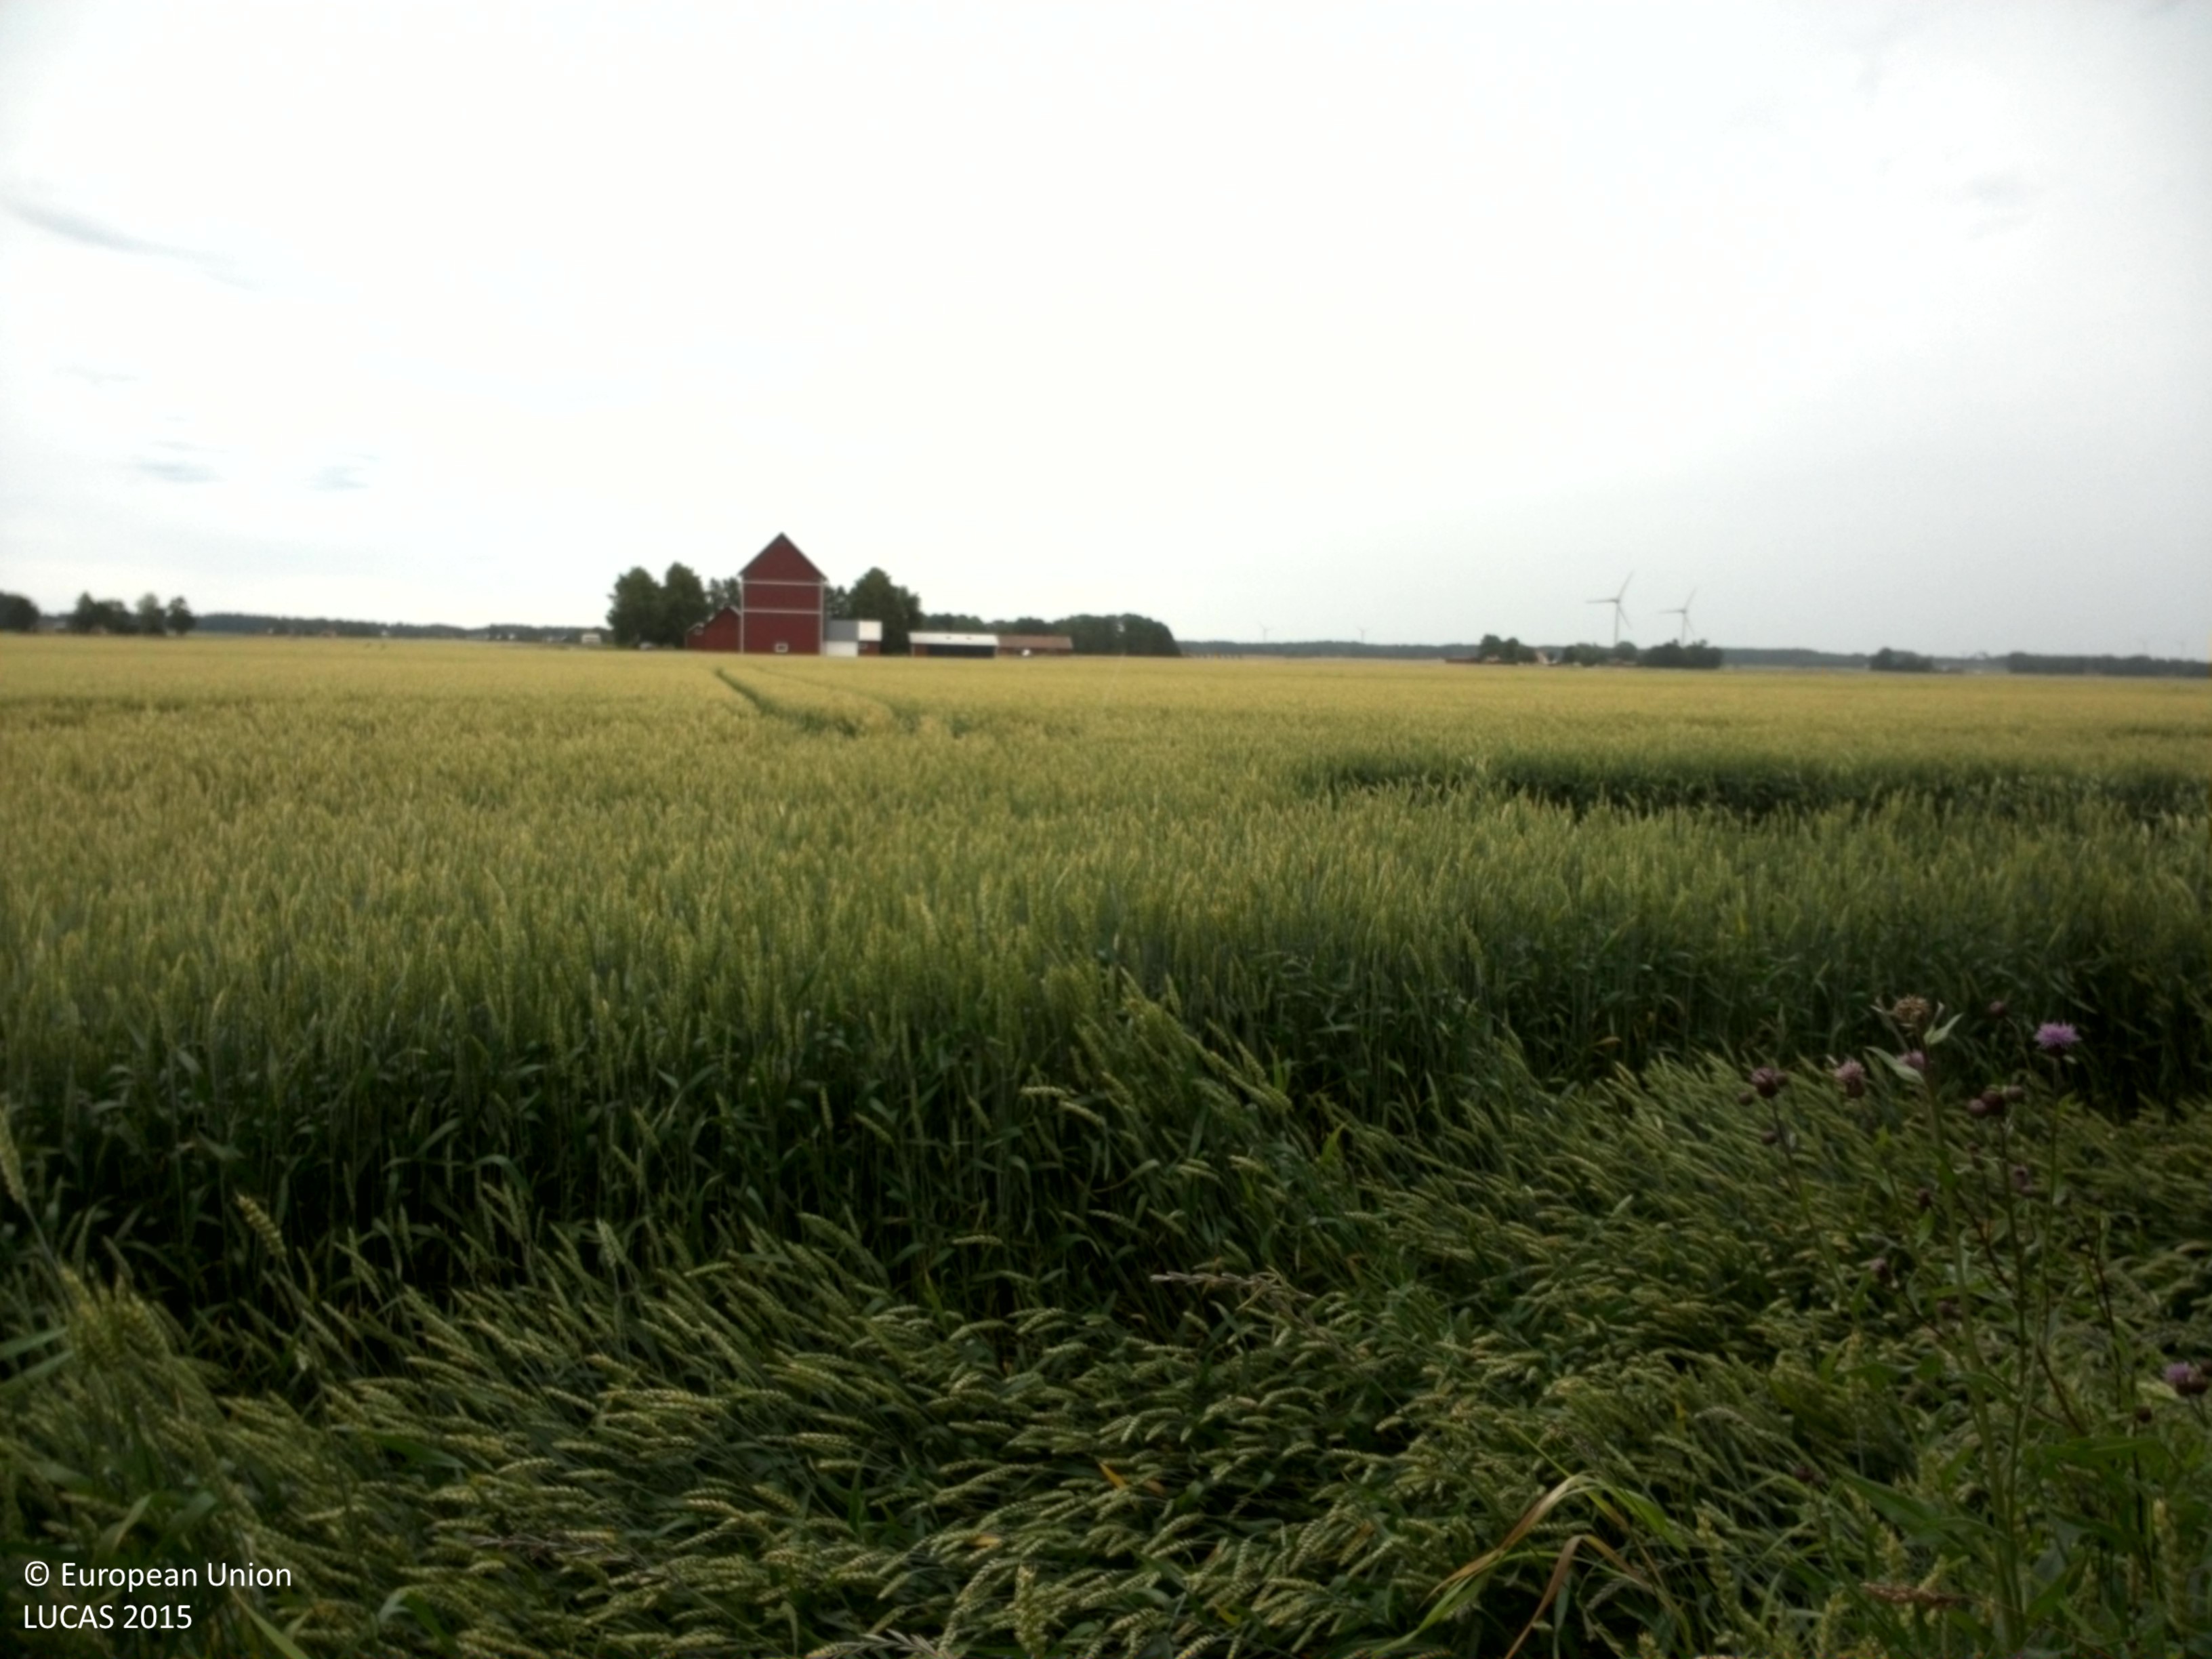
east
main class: Cropland
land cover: Common wheat
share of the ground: > 75 %
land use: Agriculture (excluding fallow land and kitchen gardens)
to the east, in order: Common wheat; Grass margins; Paved roads, cycling and walking lanes; Grass margins; Common wheat
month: July
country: SE
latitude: 58.3780
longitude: 13.2604
